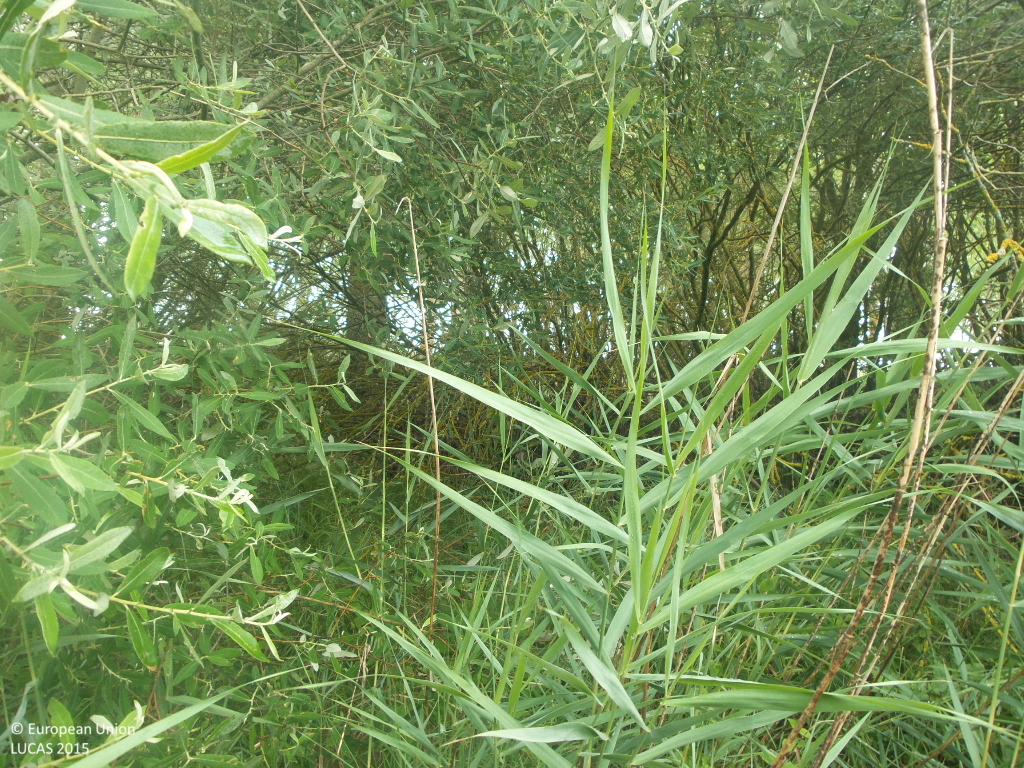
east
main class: Woodland
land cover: Broadleaved woodland
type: floodplain forest
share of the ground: > 75 %
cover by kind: broadleaved forest trees 80 %, shrubs 10 %, herbaceous plants 10 %
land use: Semi-natural and natural areas not in use
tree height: > 5 m
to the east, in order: Broadleaved woodland; Common wheat; Grass margins; Ditches and canals; Grass margins; Common wheat
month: June
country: ES
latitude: 41.4978
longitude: -2.7482
